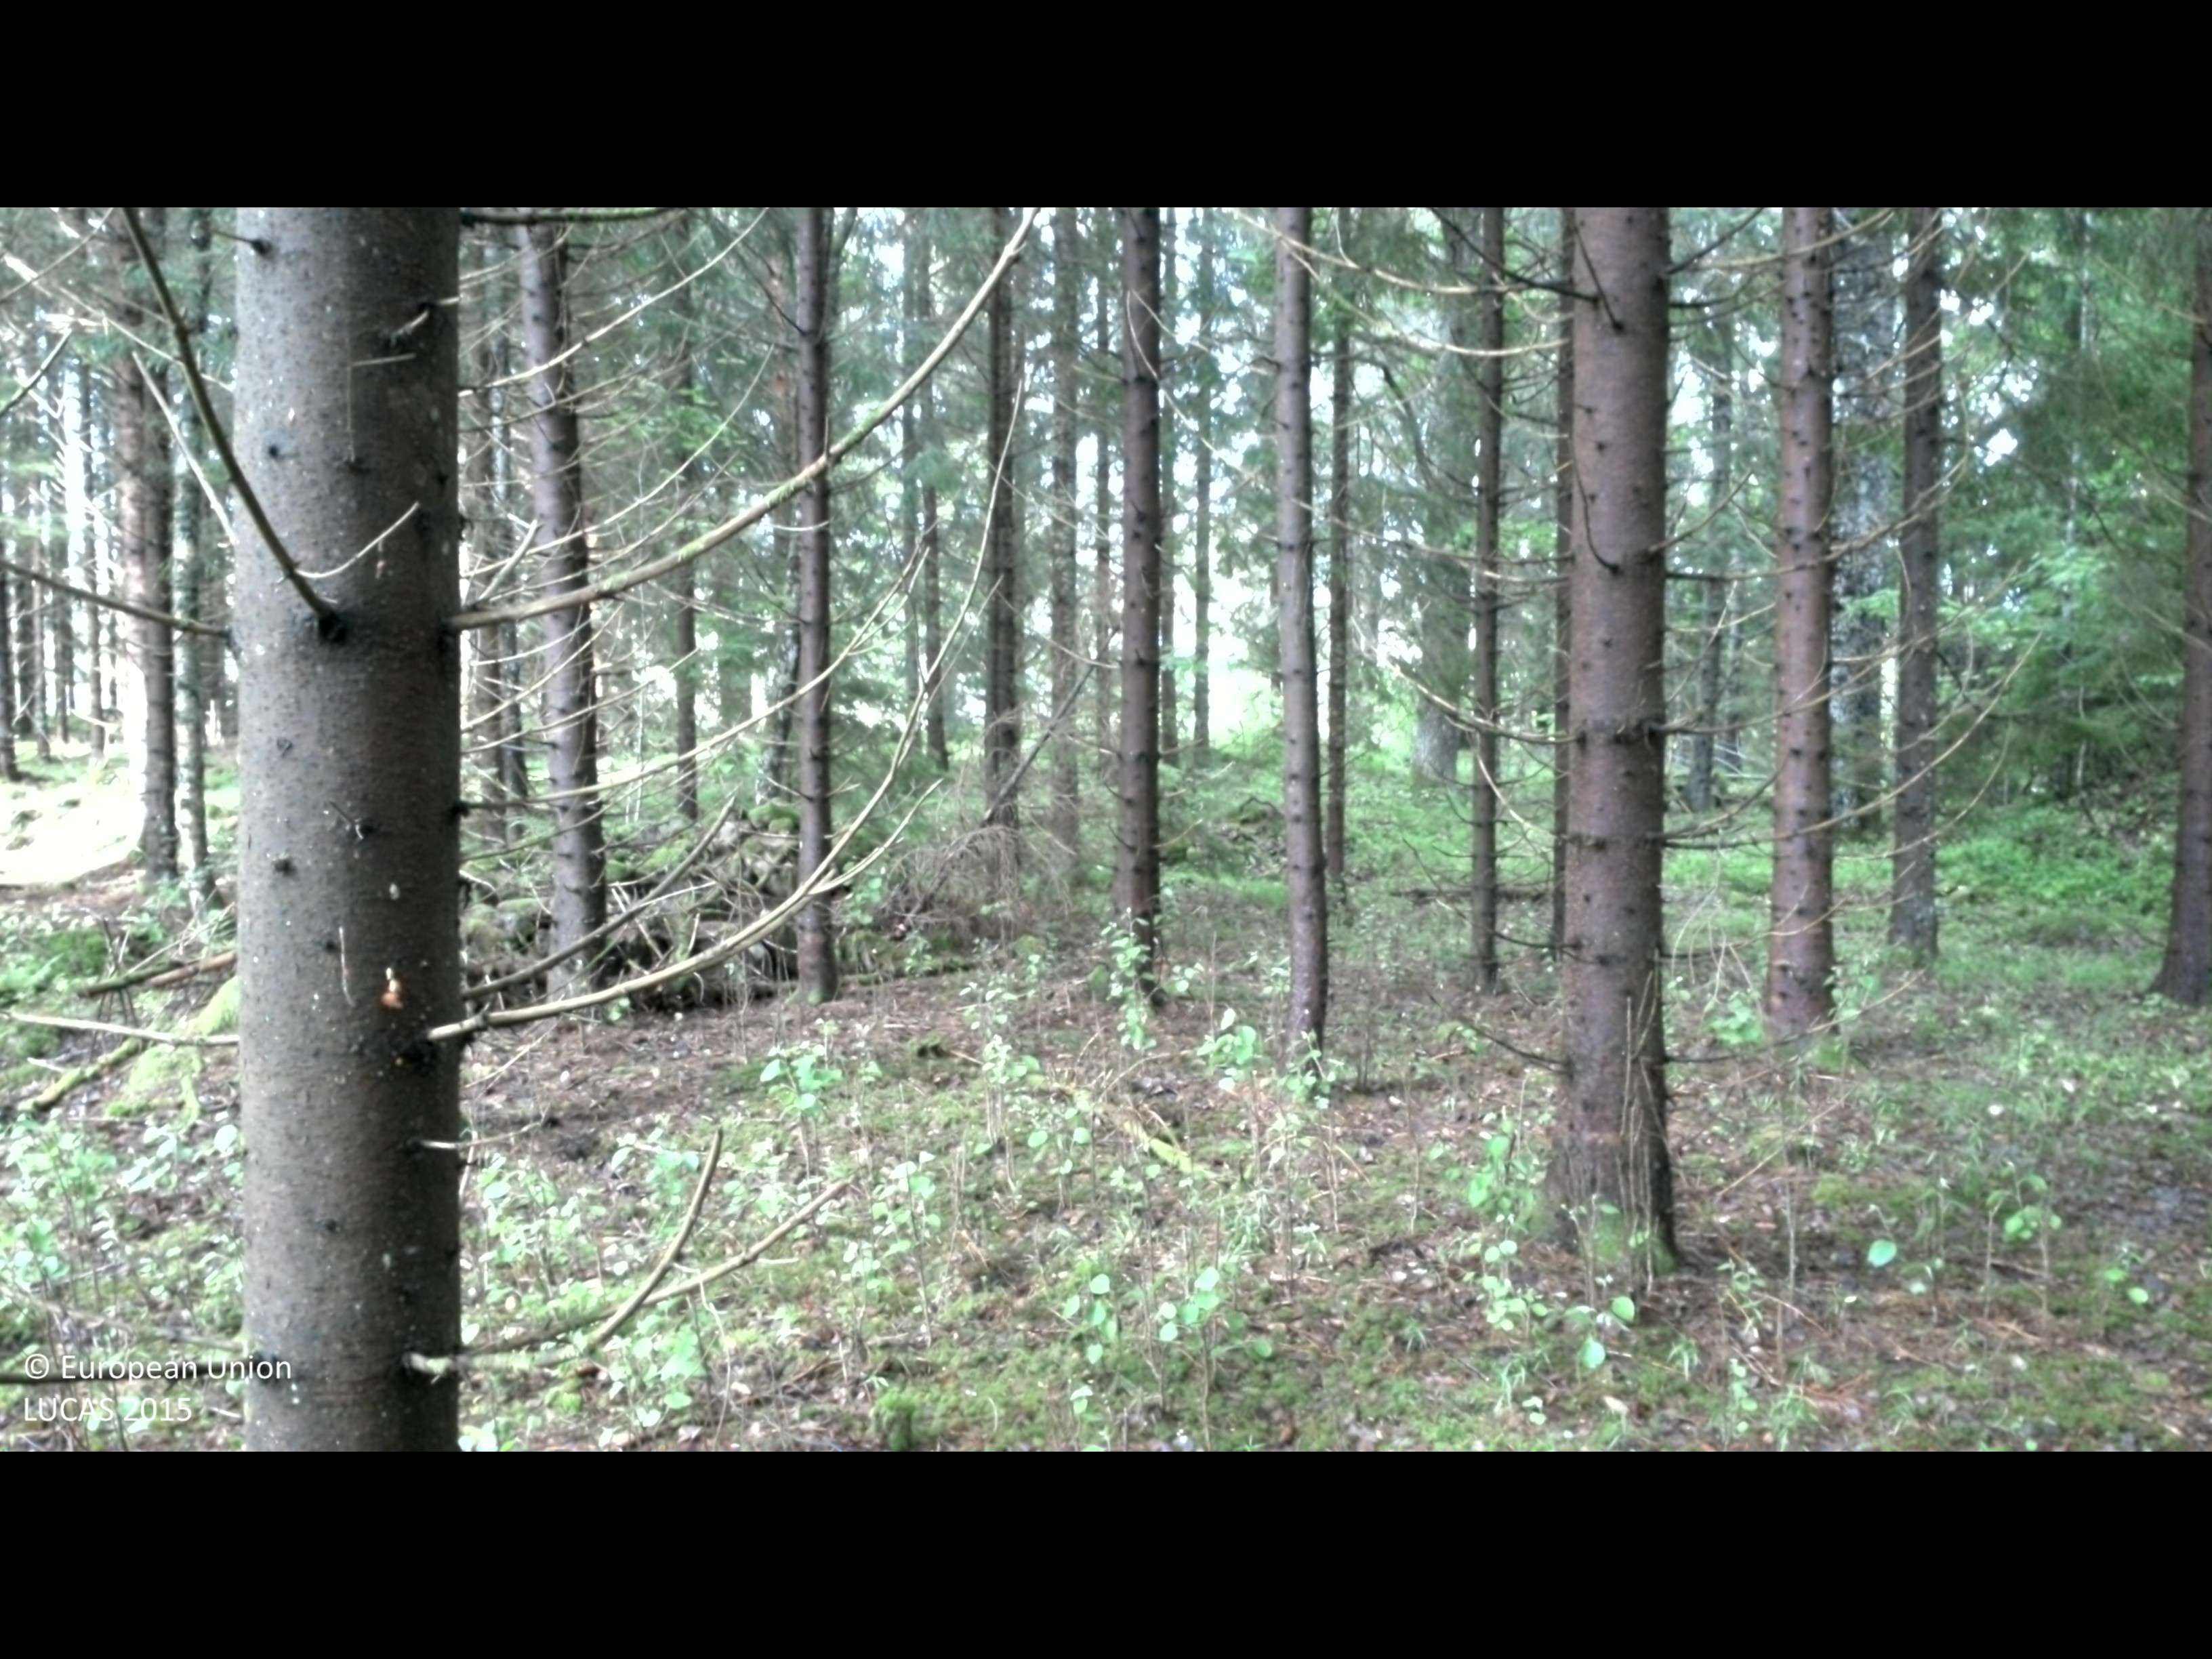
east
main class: Woodland
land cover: Spruce dominated coniferous woodland
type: boreal forest
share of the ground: > 75 %
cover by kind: coniferous forest trees 85 %, lichens and mosses 10 %, broadleaved forest trees 5 %
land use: Forestry
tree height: > 5 m
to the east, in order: Spruce dominated coniferous woodland; Ditches and canals; Spruce dominated coniferous woodland; Fences; Tracks; Grassland without tree/shrub cover; Broadleaved woodland; Grassland with sparse tree/shrub cover; Fences; Broadleaved woodland; Shrubland with sparse tree cover
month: June
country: SE
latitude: 58.1161
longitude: 16.1241
